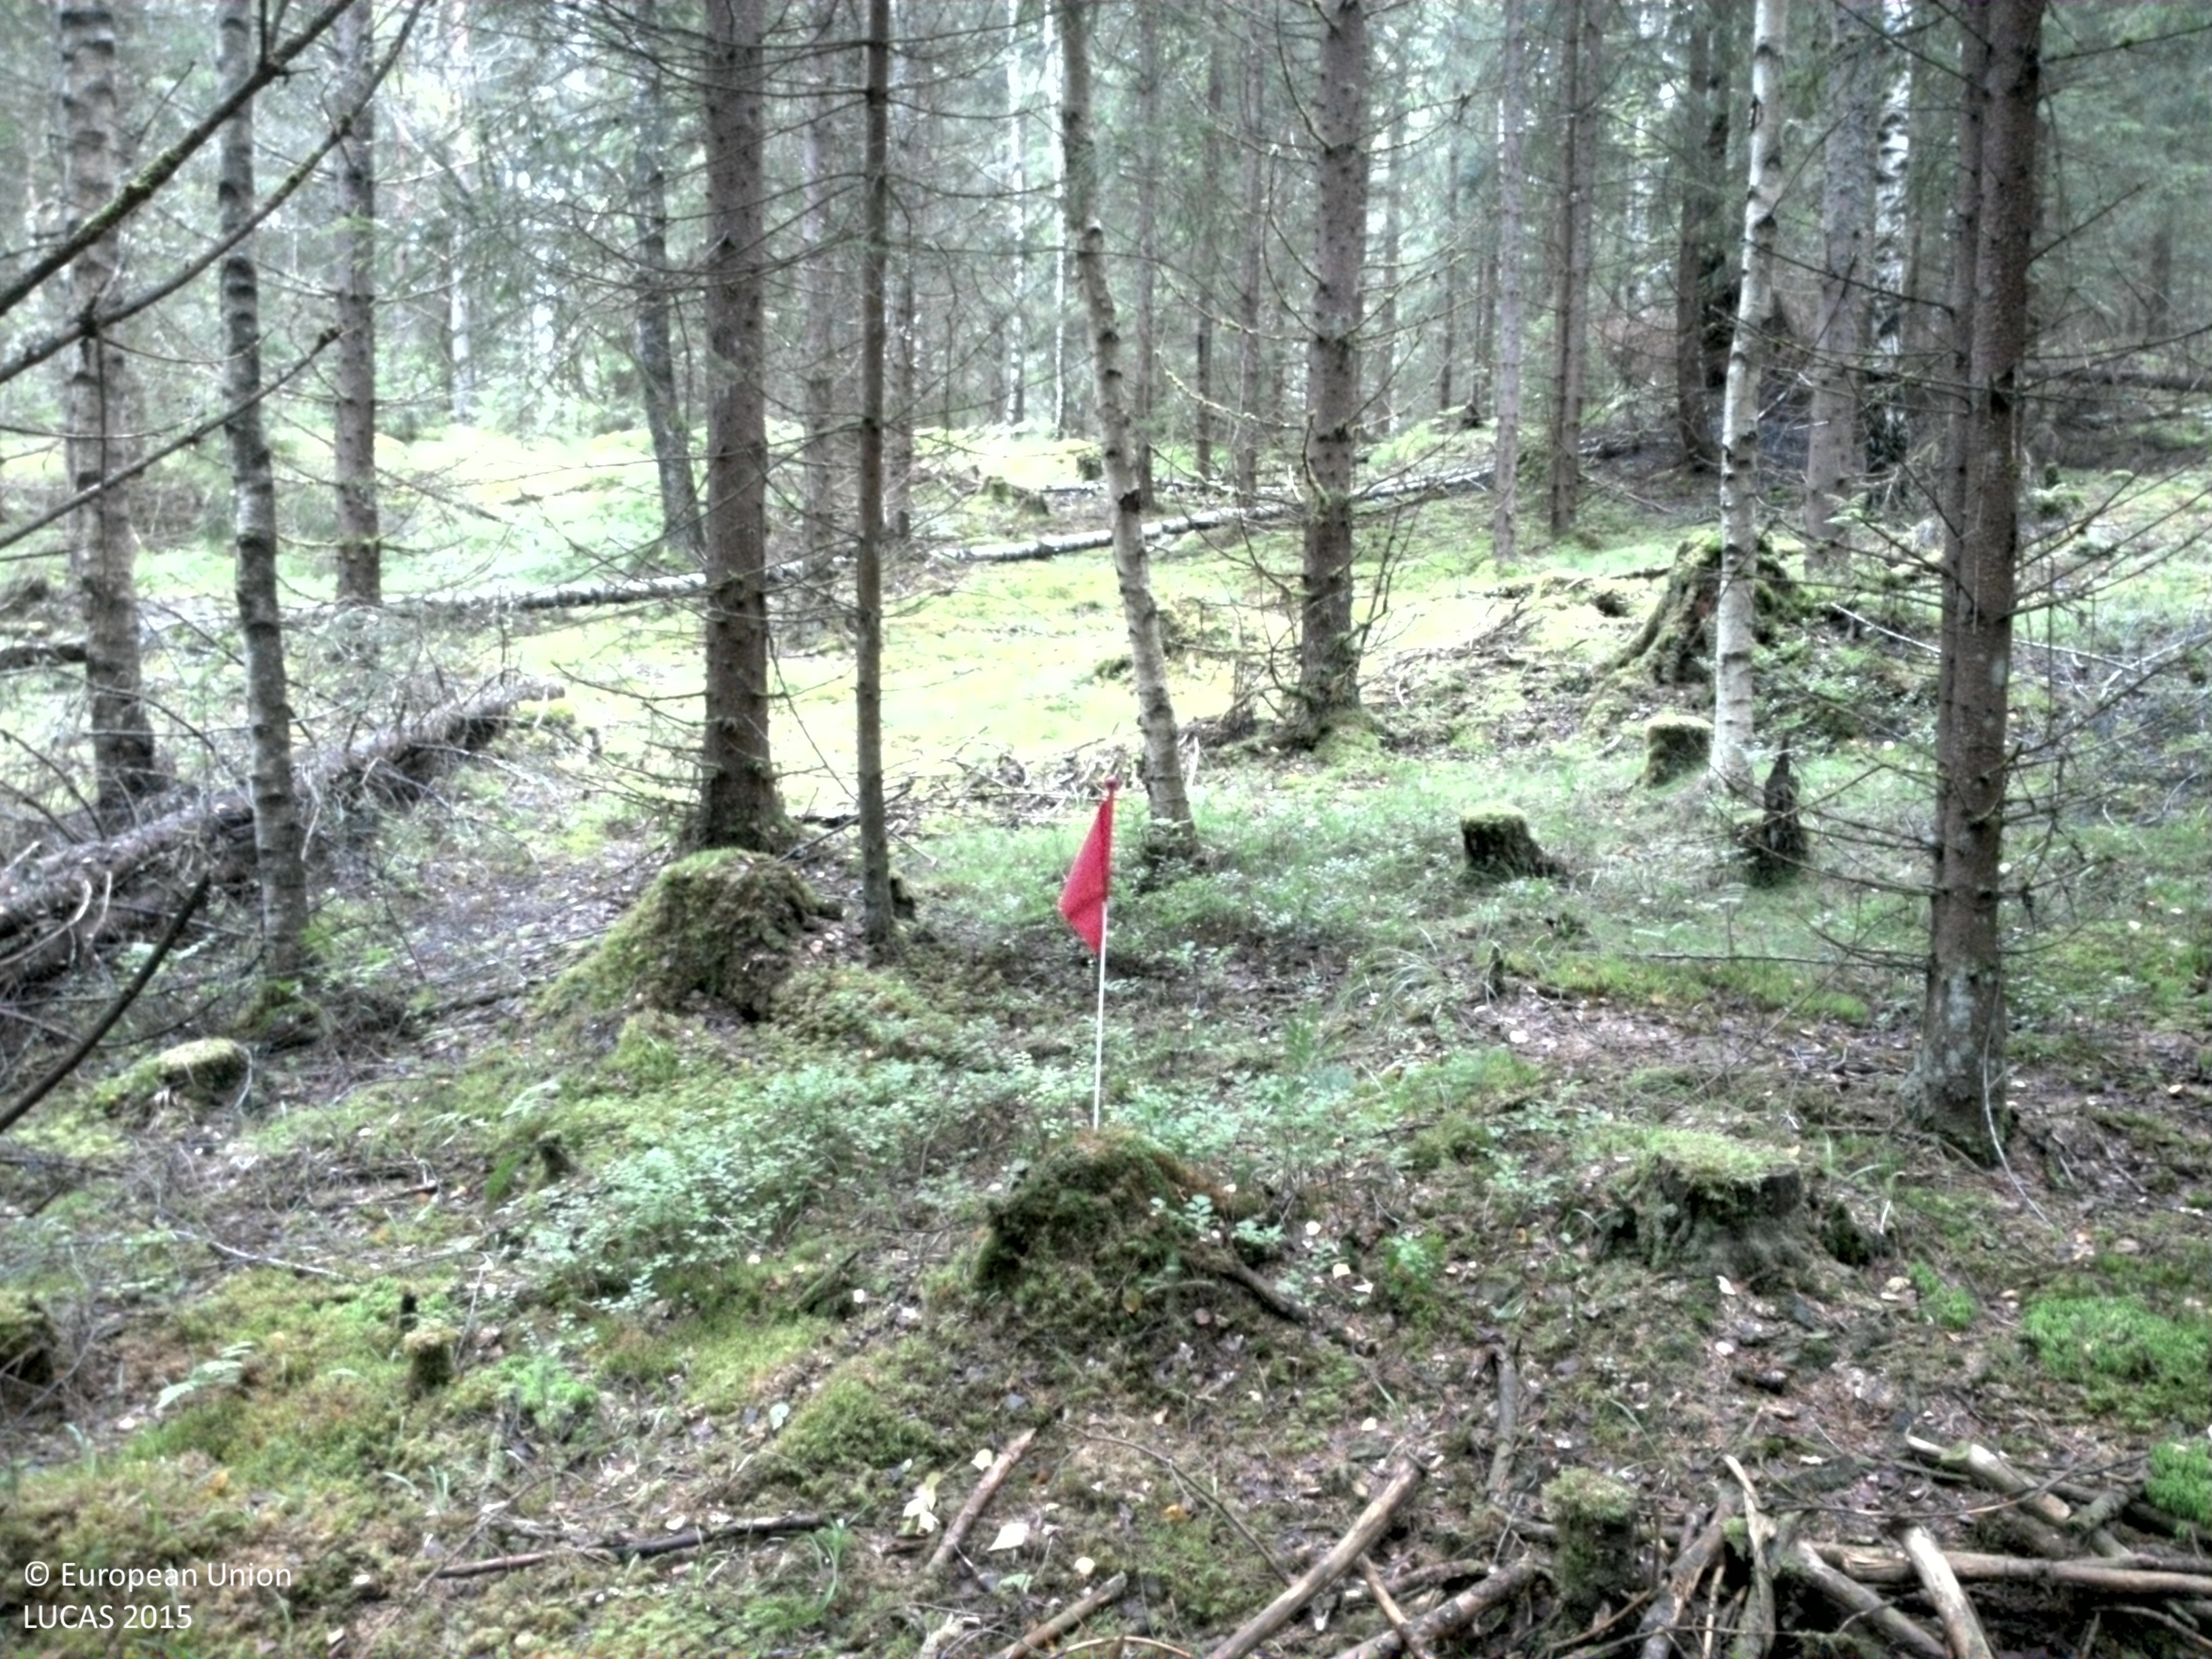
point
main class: Woodland
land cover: Spruce dominated coniferous woodland
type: boreal forest
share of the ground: 50 - 75 %
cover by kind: coniferous forest trees 65 %, lichens and mosses 20 %, broadleaved forest trees 5 %, shrubs 5 %, herbaceous plants 5 %
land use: Forestry
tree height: > 5 m
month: August
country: SE
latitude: 59.6219
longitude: 13.2009
